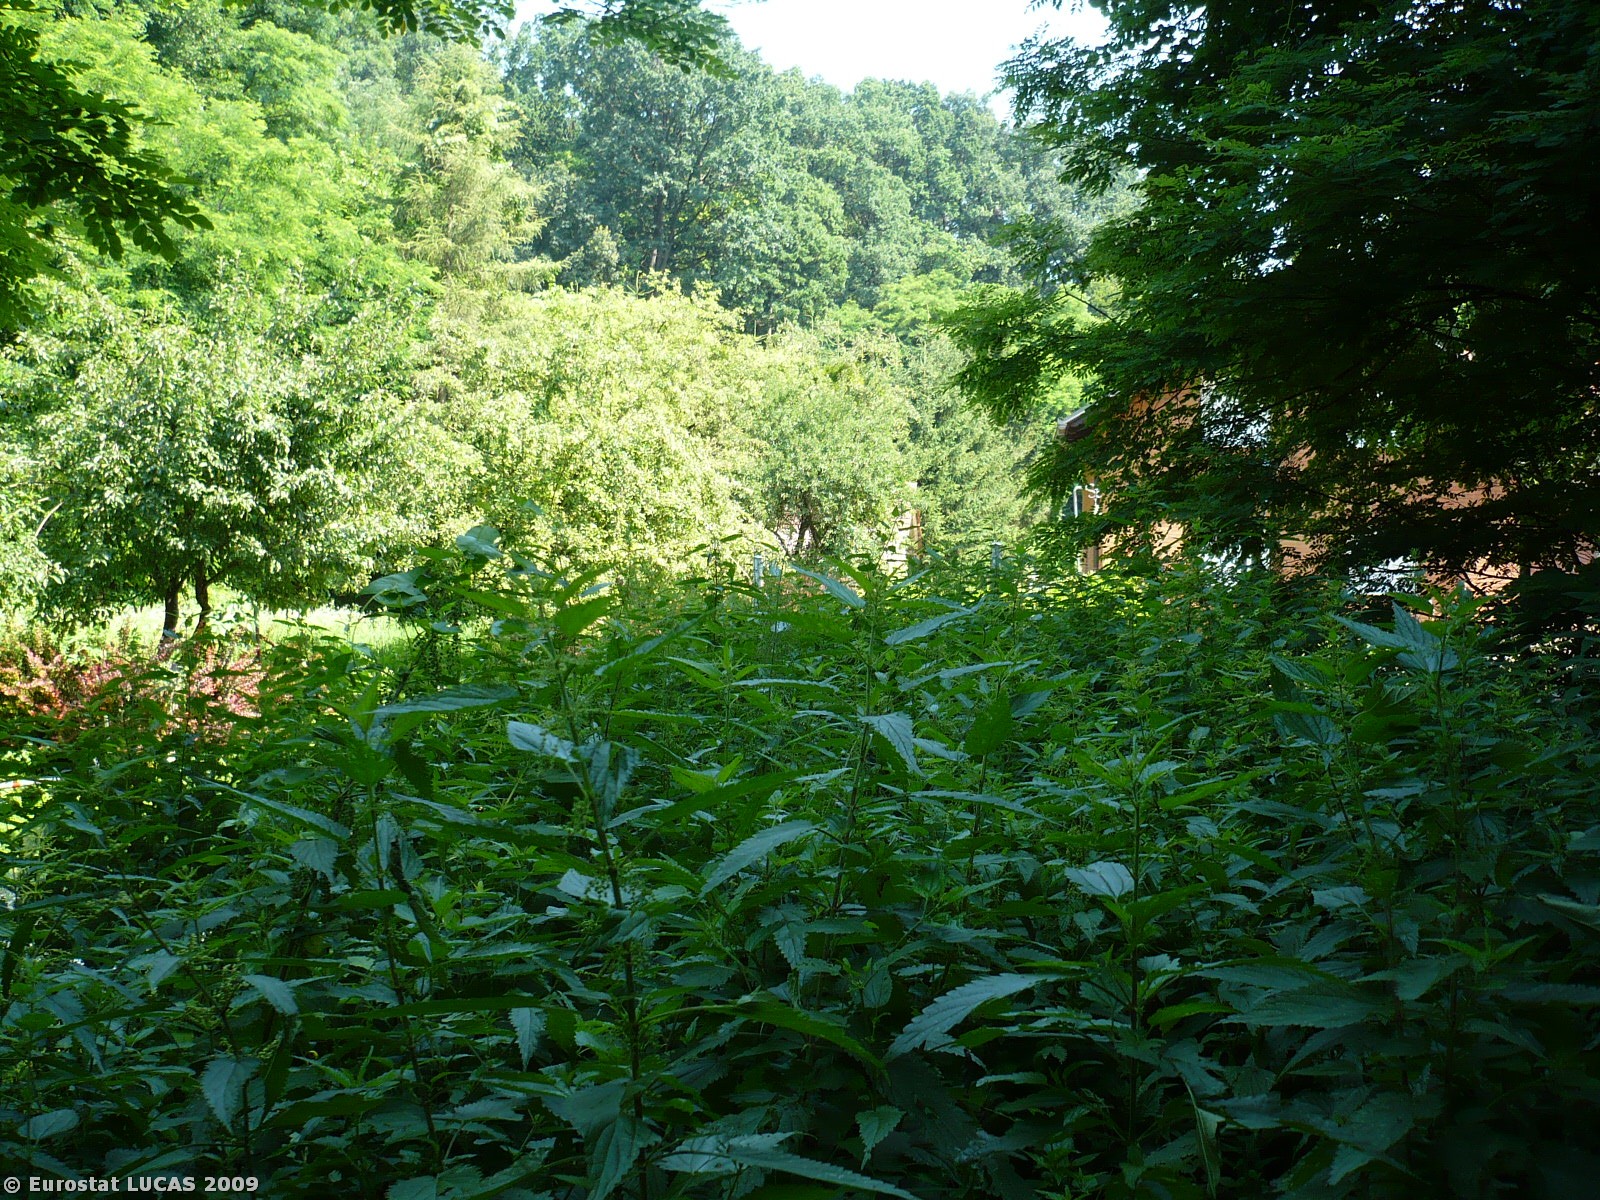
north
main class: Woodland
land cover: Broadleaved woodland
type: mesophytic deciduous forest
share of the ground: > 75 %
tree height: > 5 m
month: July
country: SI
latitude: 46.5503
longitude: 16.5094
